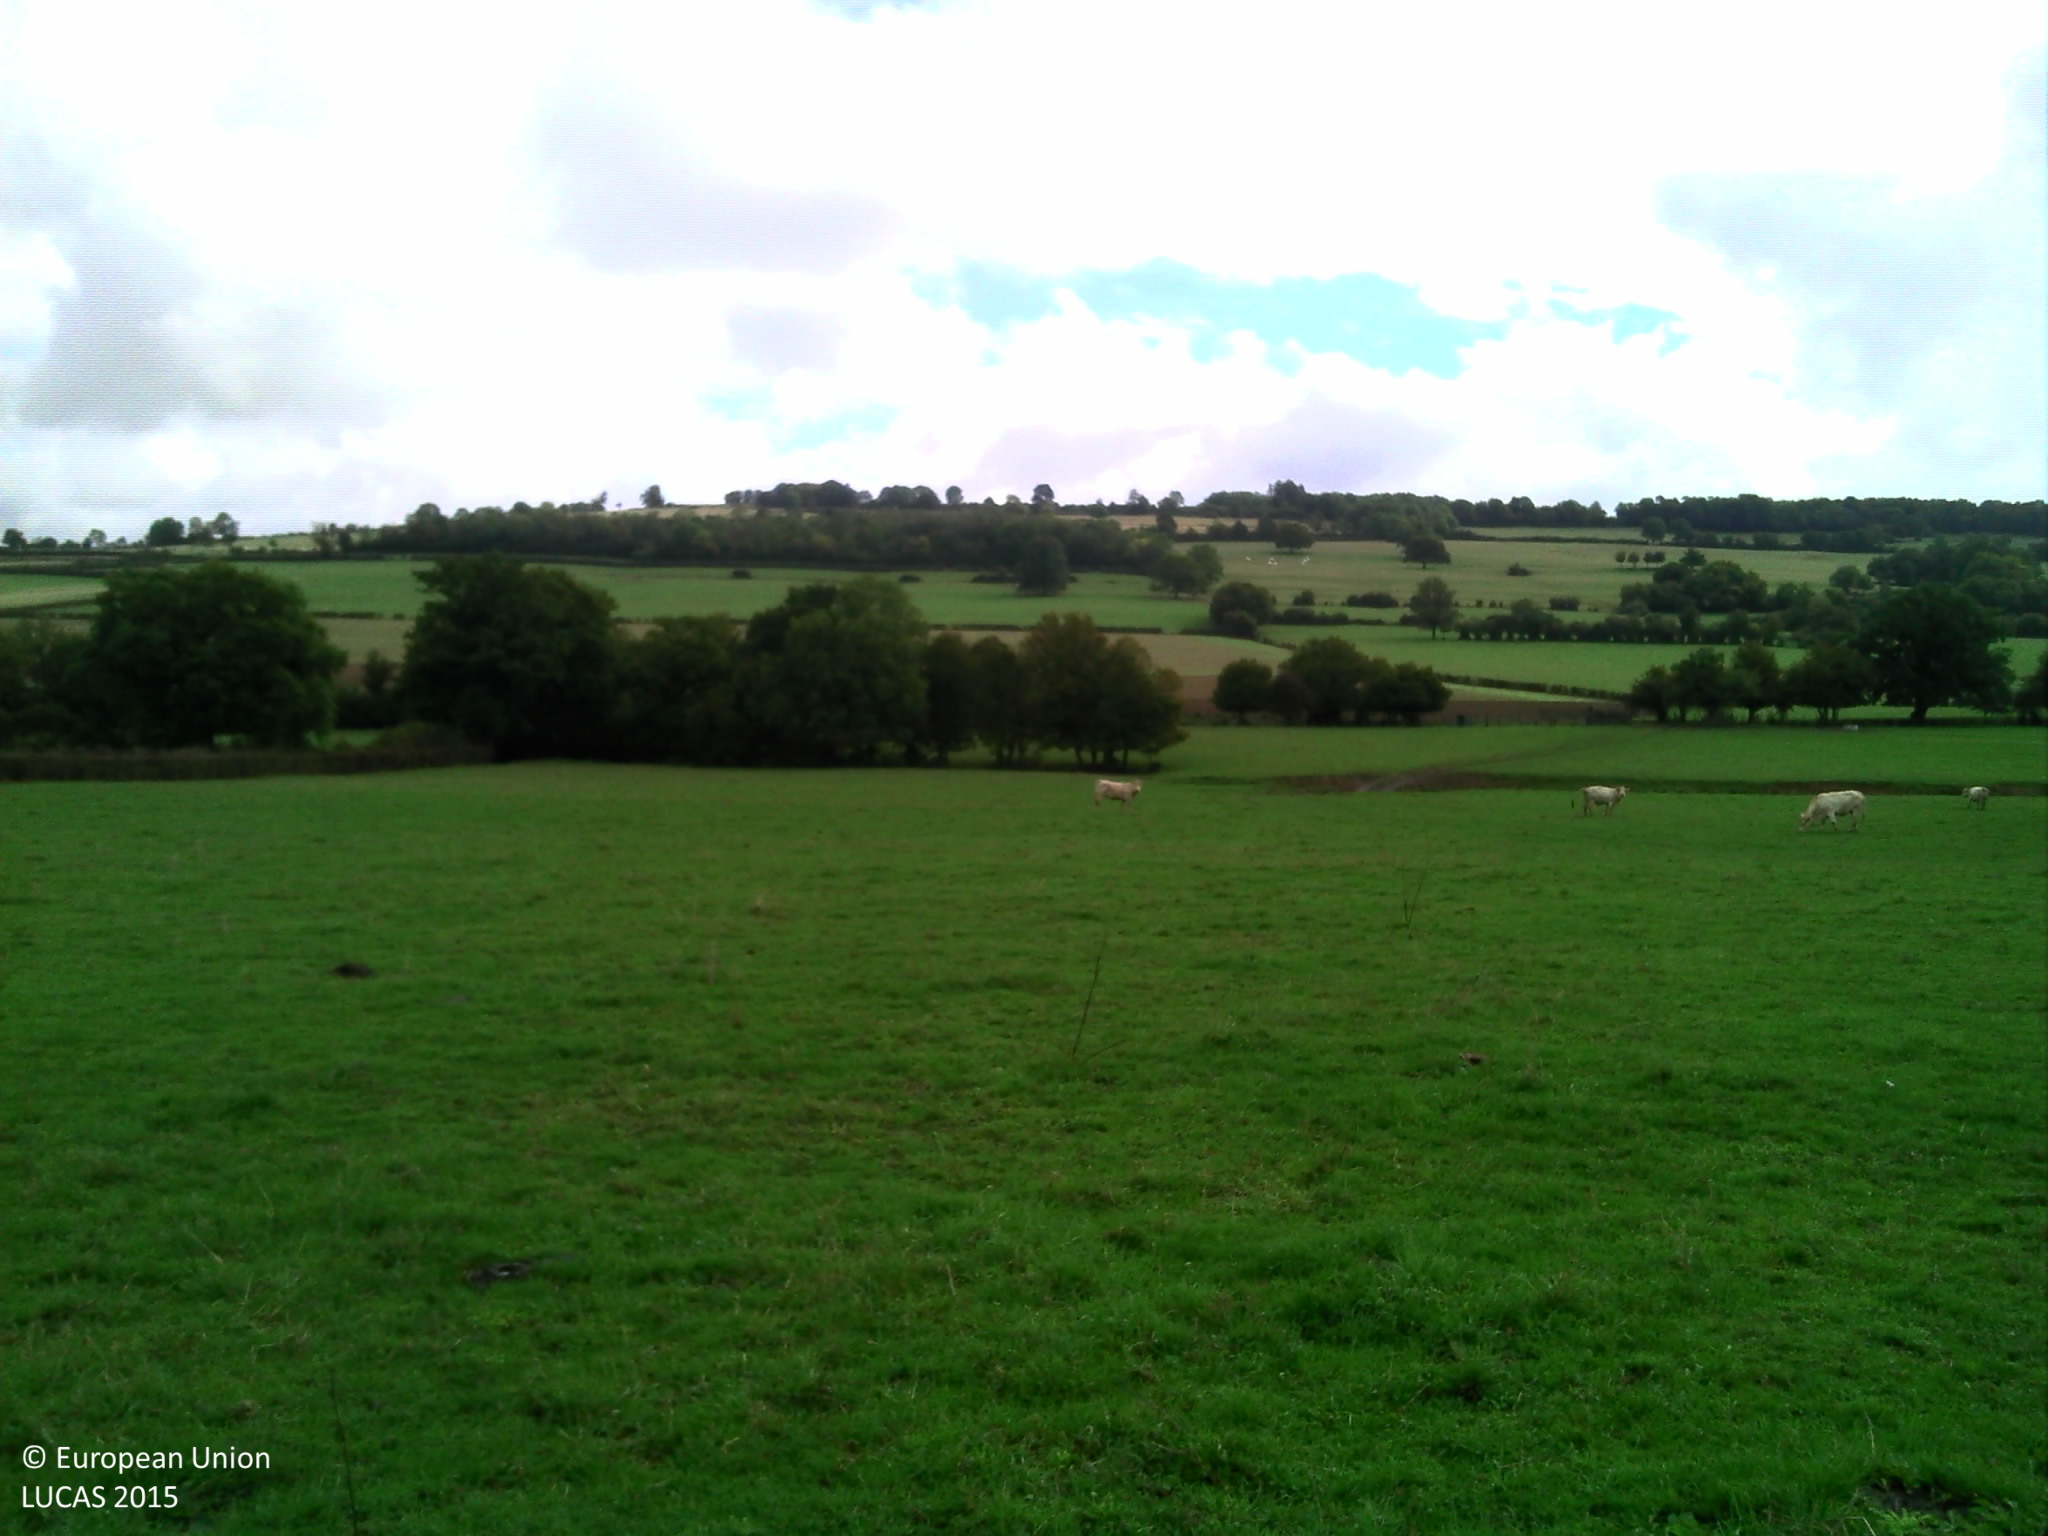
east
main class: Grassland
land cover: Grassland without tree/shrub cover
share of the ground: > 75 %
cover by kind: herbaceous plants 100 %
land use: Agriculture (excluding fallow land and kitchen gardens)
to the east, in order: Grassland without tree/shrub cover; Rivers and streams; Broadleaved woodland; Grassland without tree/shrub cover; Fences; Managed hedges; Grassland without tree/shrub cover; Broadleaved woodland; Grass margins; Tracks; Grass margins; Other bare soil
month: September
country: FR
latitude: 47.2492
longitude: 4.3575
